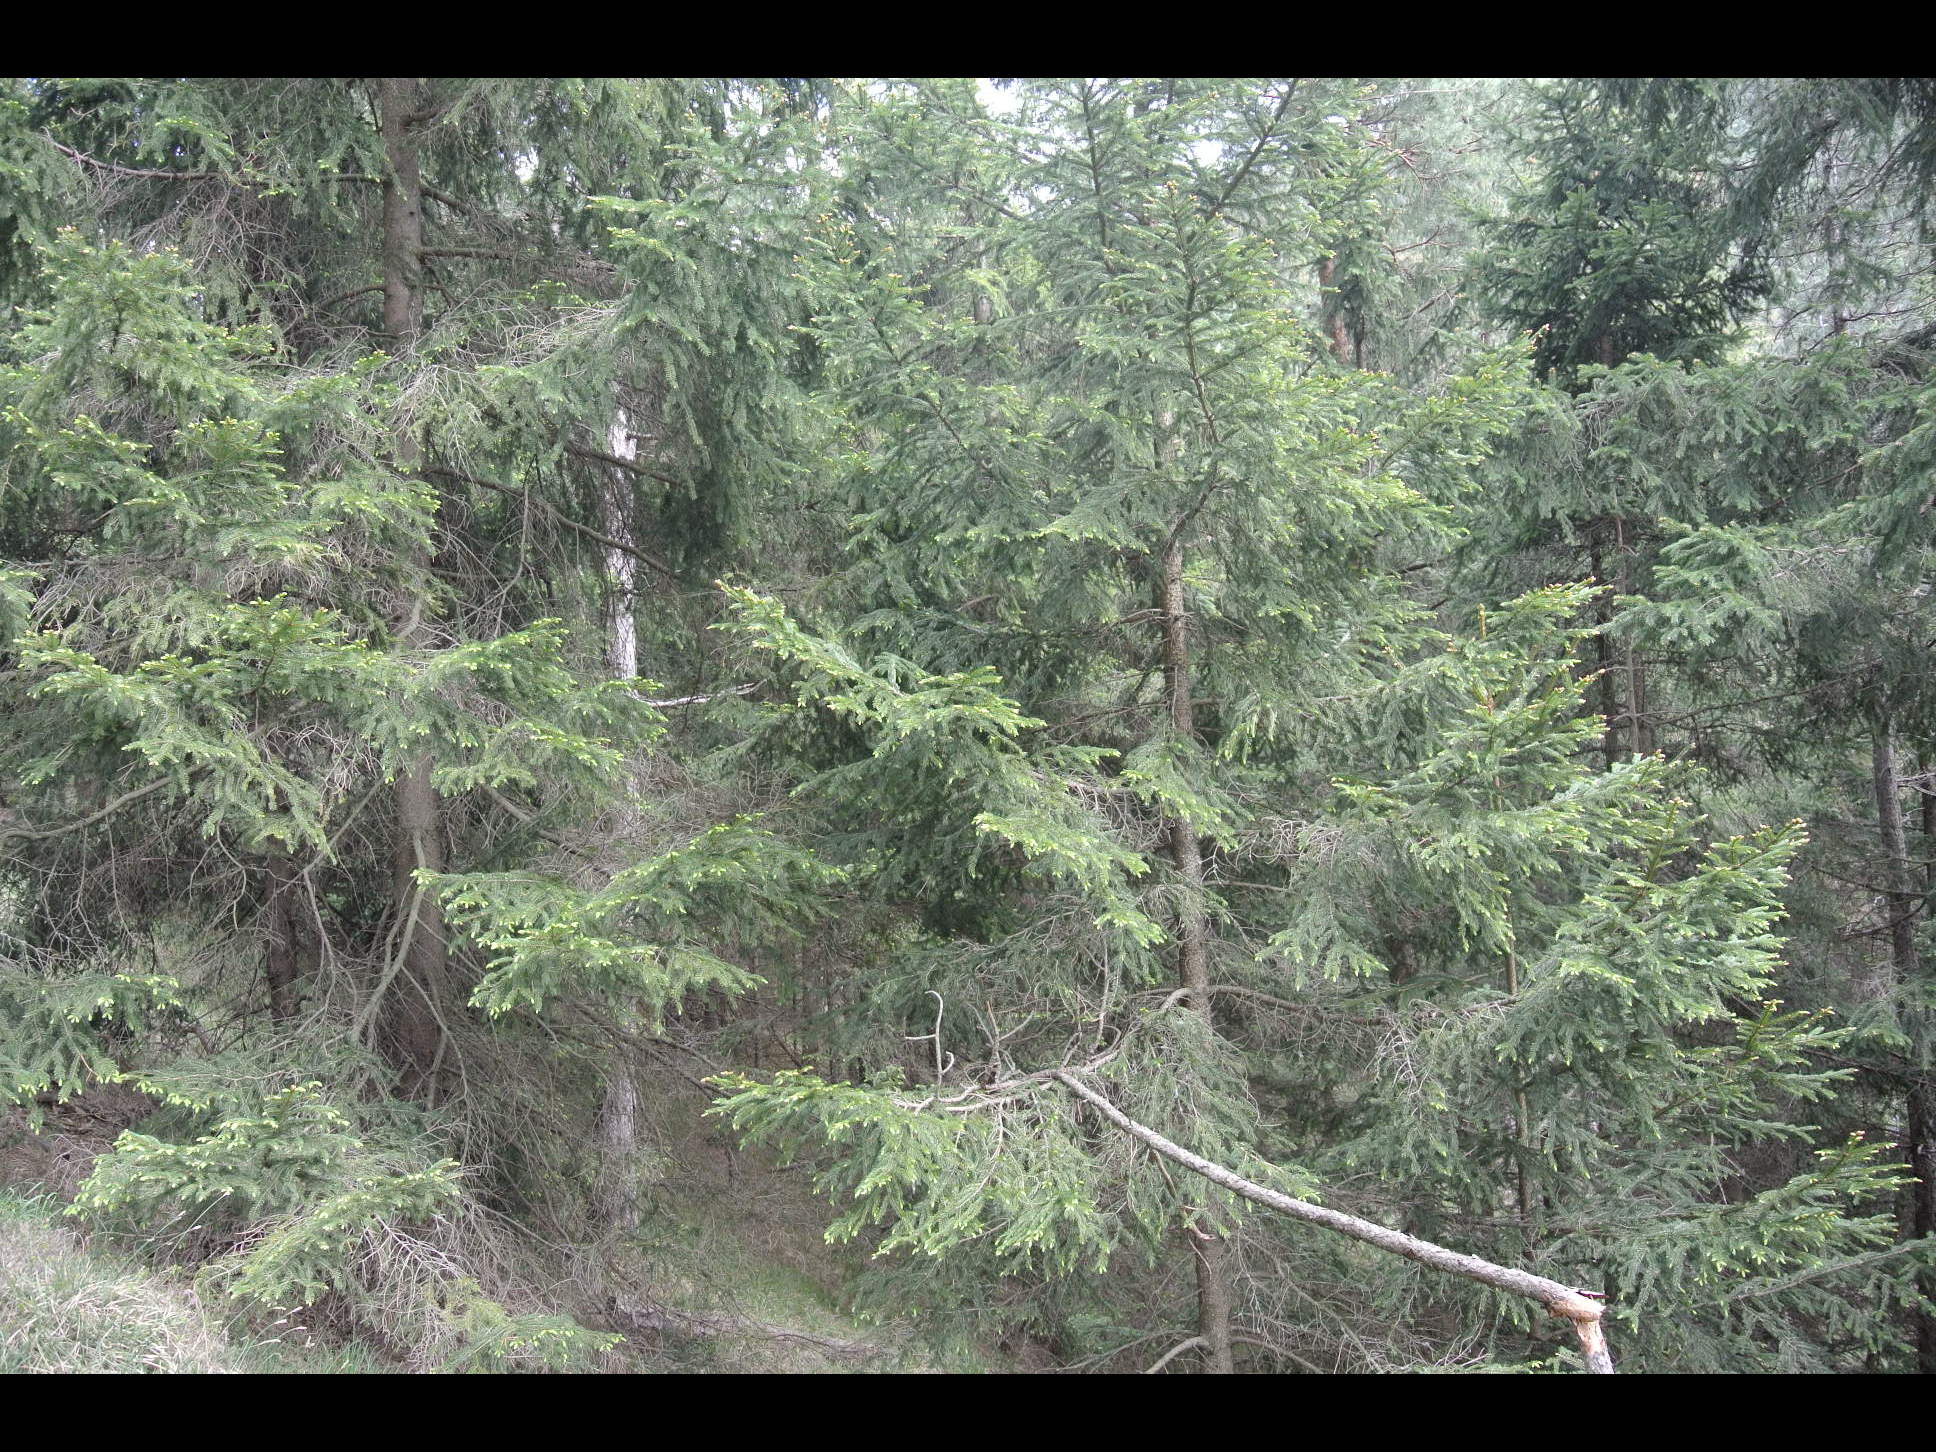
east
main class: Woodland
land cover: Pine dominated mixed woodland
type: alpine coniferous forest
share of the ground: > 75 %
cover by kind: coniferous forest trees 70 %, broadleaved forest trees 25 %, herbaceous plants 5 %
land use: Forestry
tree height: > 5 m
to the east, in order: Pine dominated mixed woodland; Pine dominated coniferous woodland
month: May
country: AT
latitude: 47.9152
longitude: 16.0111
